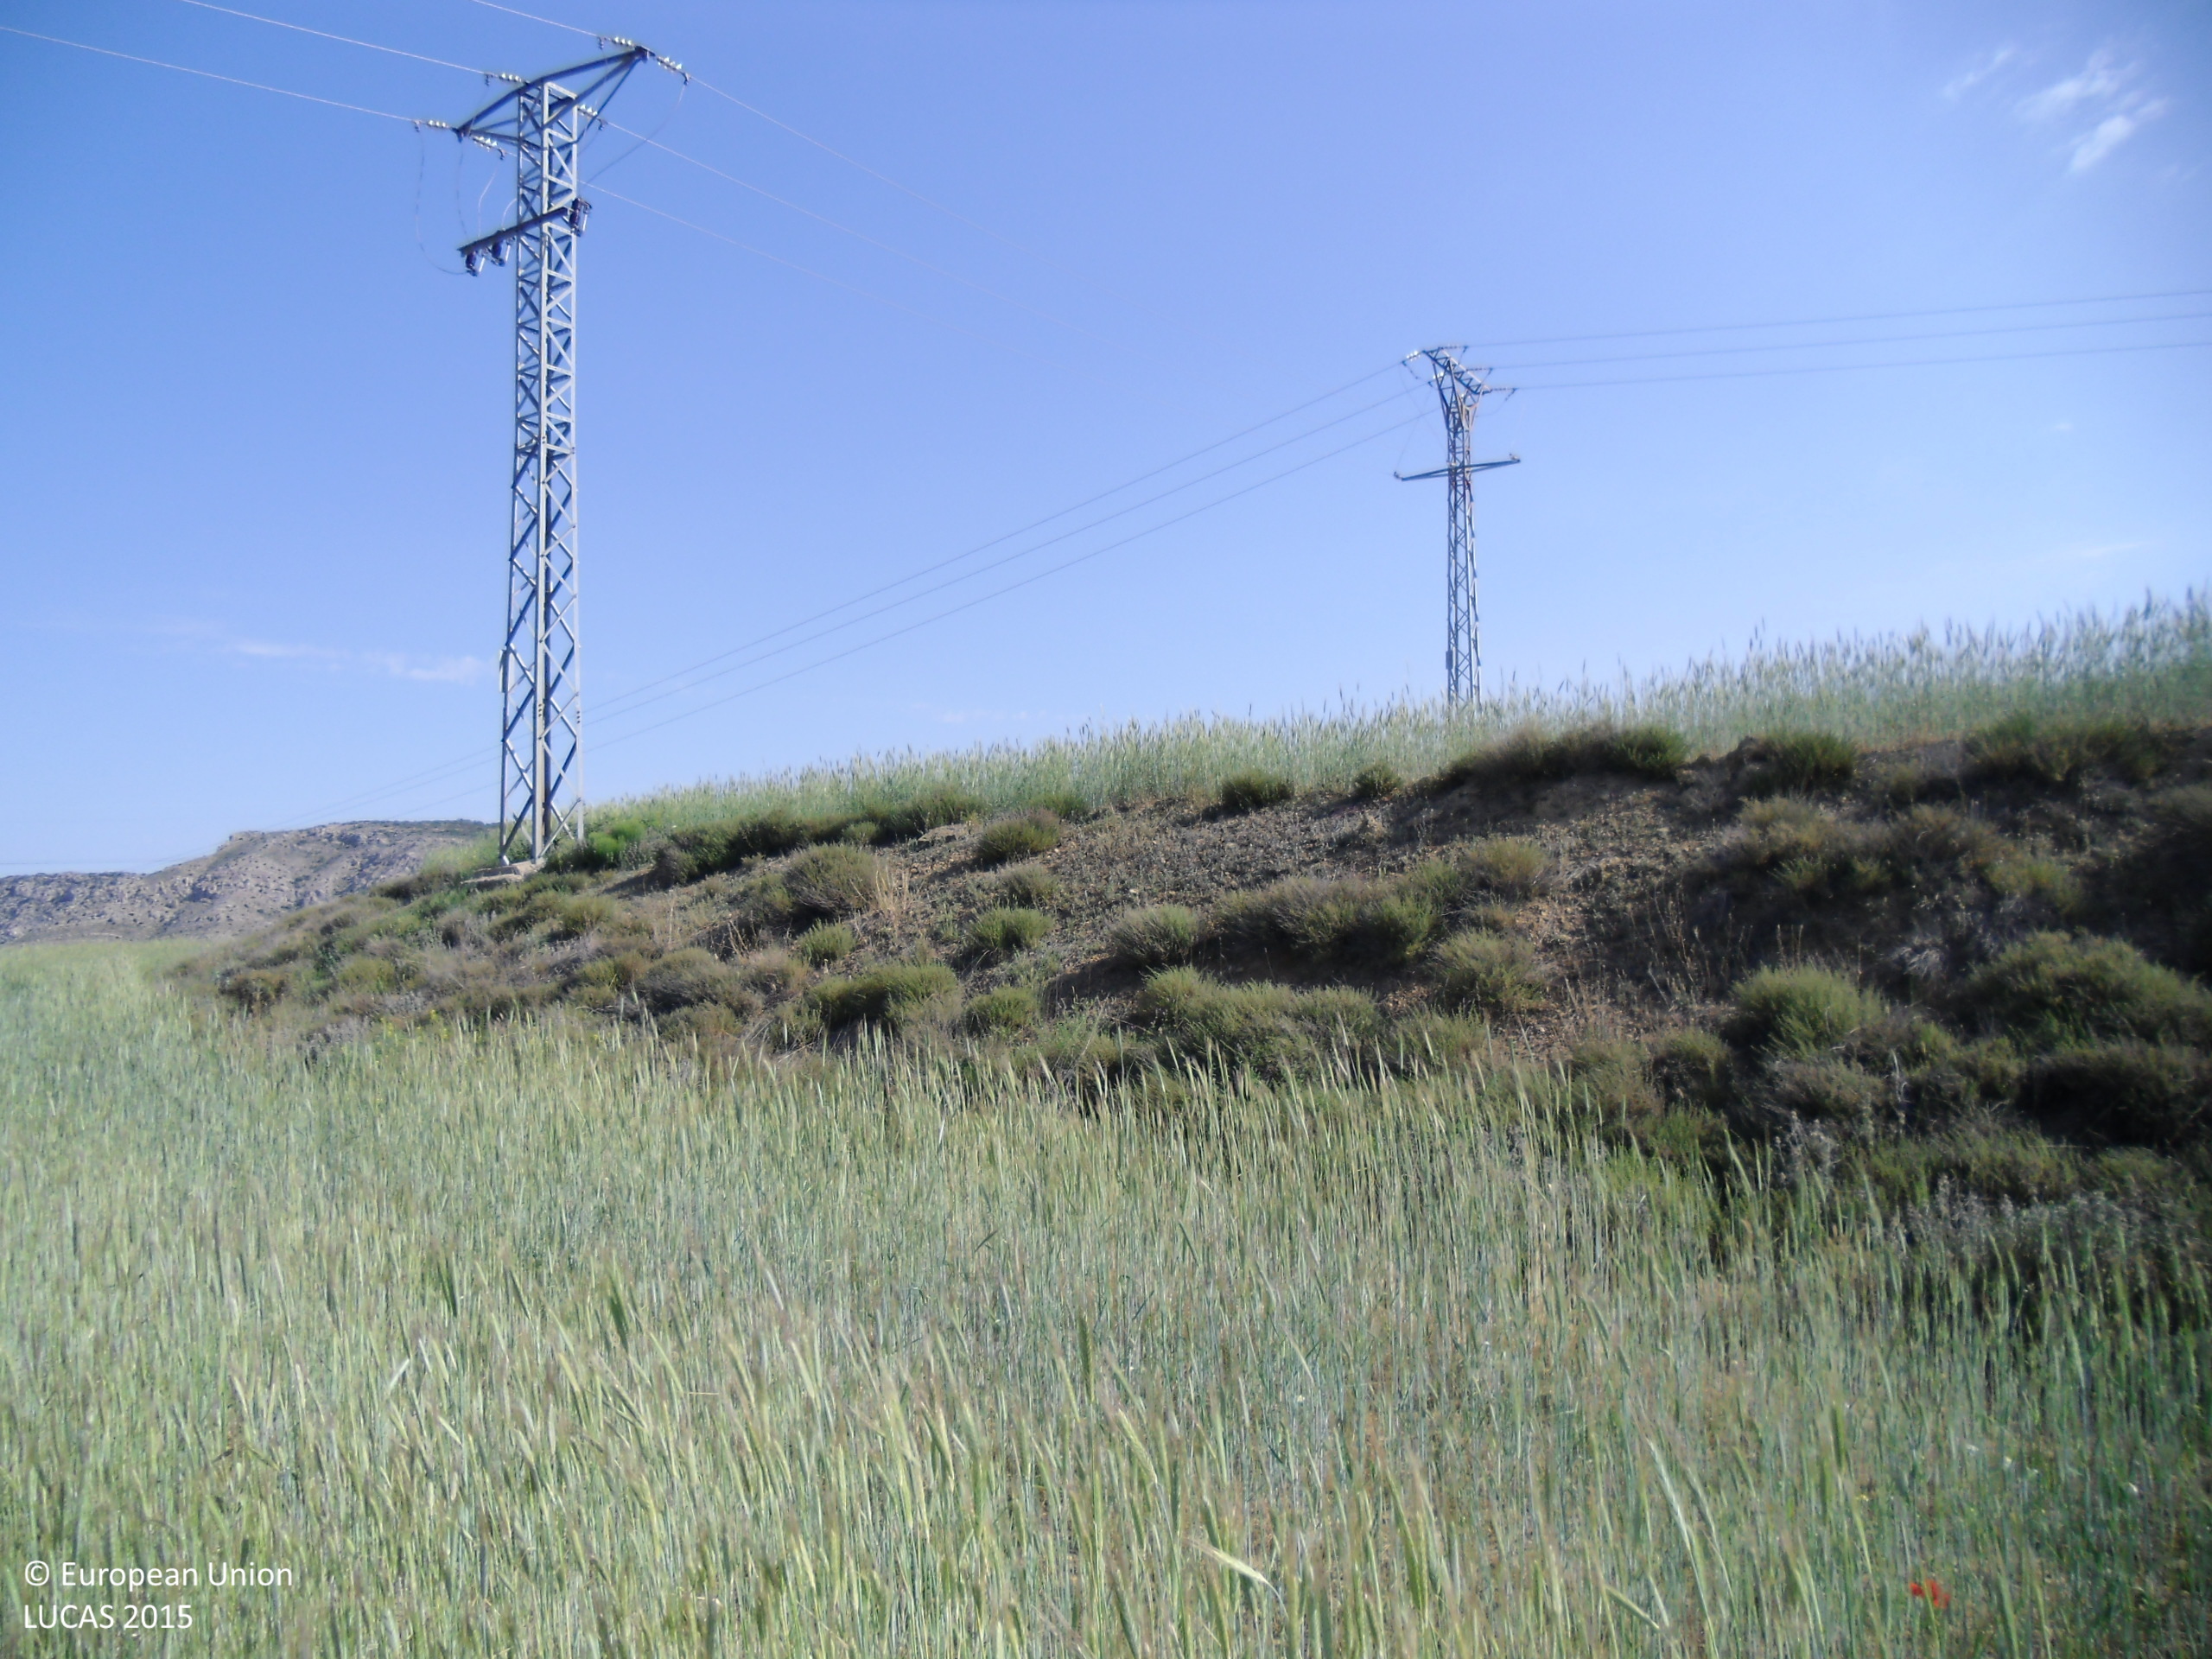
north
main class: Cropland
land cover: Rye
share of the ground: > 75 %
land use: Agriculture (excluding fallow land and kitchen gardens)
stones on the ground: < 10 %
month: May
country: ES
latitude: 40.7986
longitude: -0.8108
